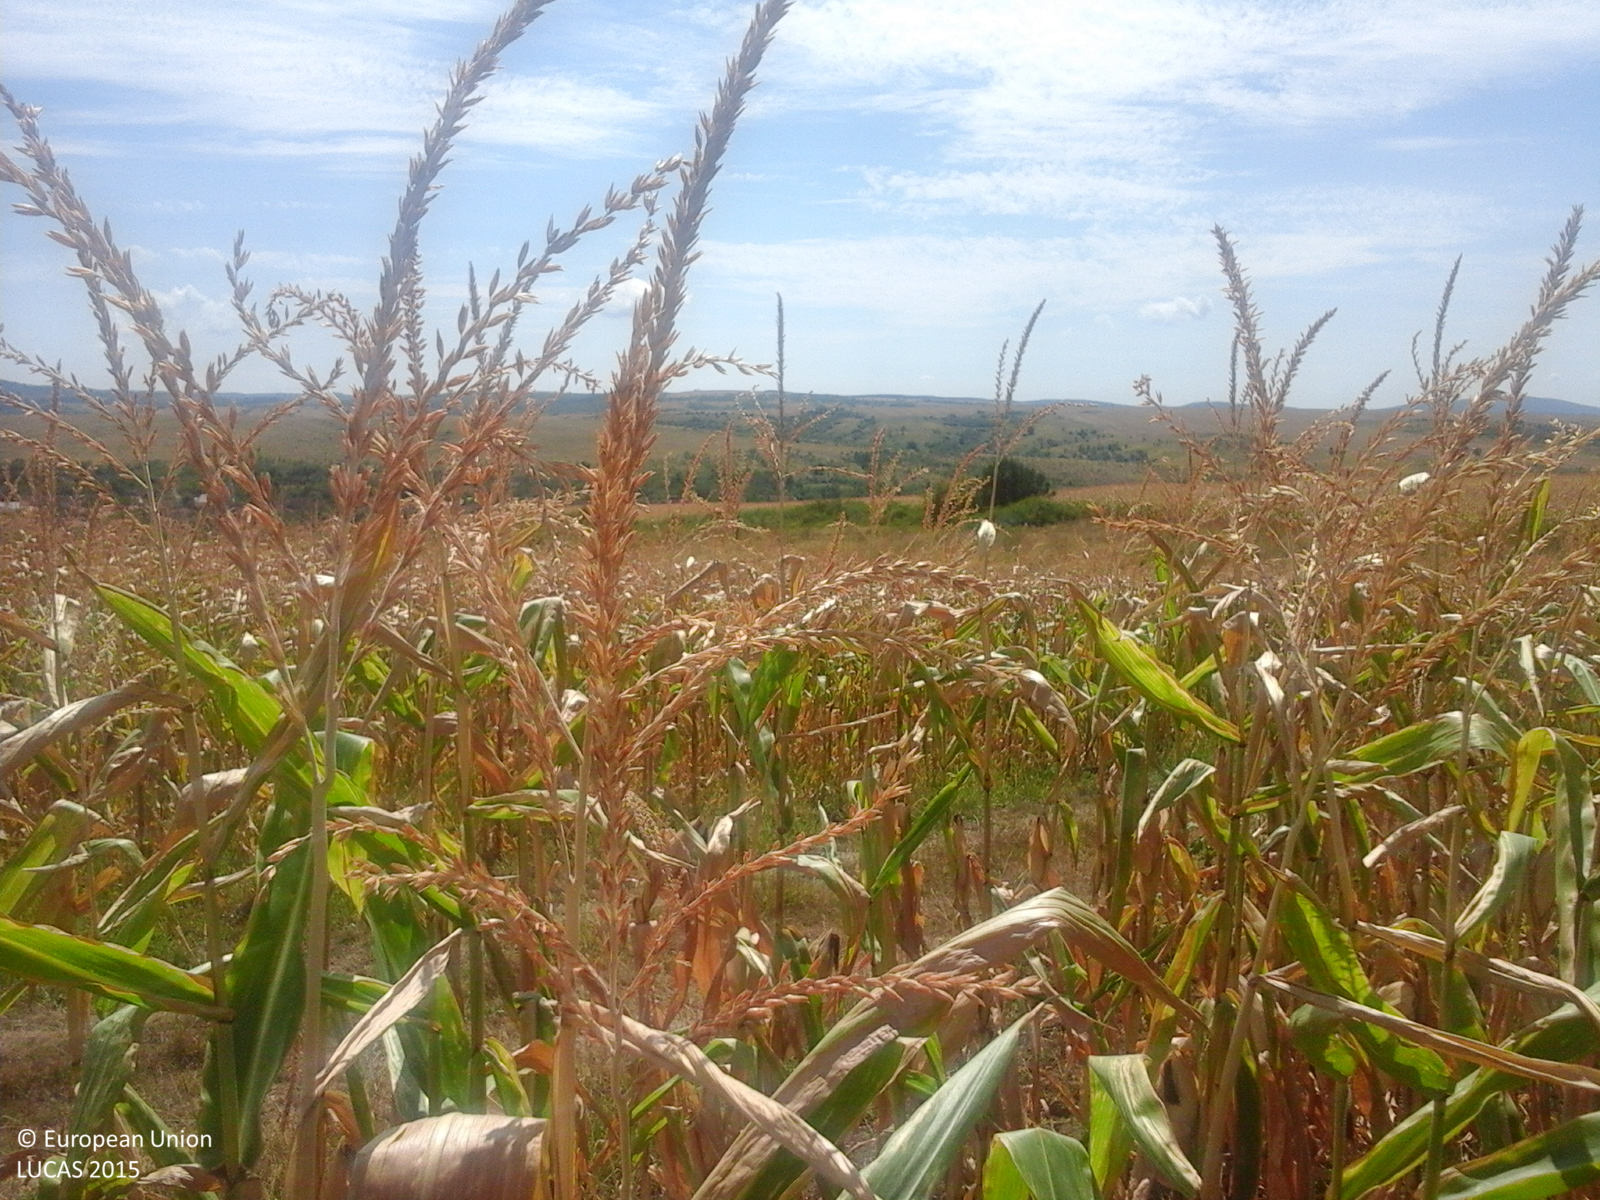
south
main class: Cropland
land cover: Maize
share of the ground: > 75 %
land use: Agriculture (excluding fallow land and kitchen gardens)
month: August
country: RO
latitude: 44.9477
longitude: 21.6530
